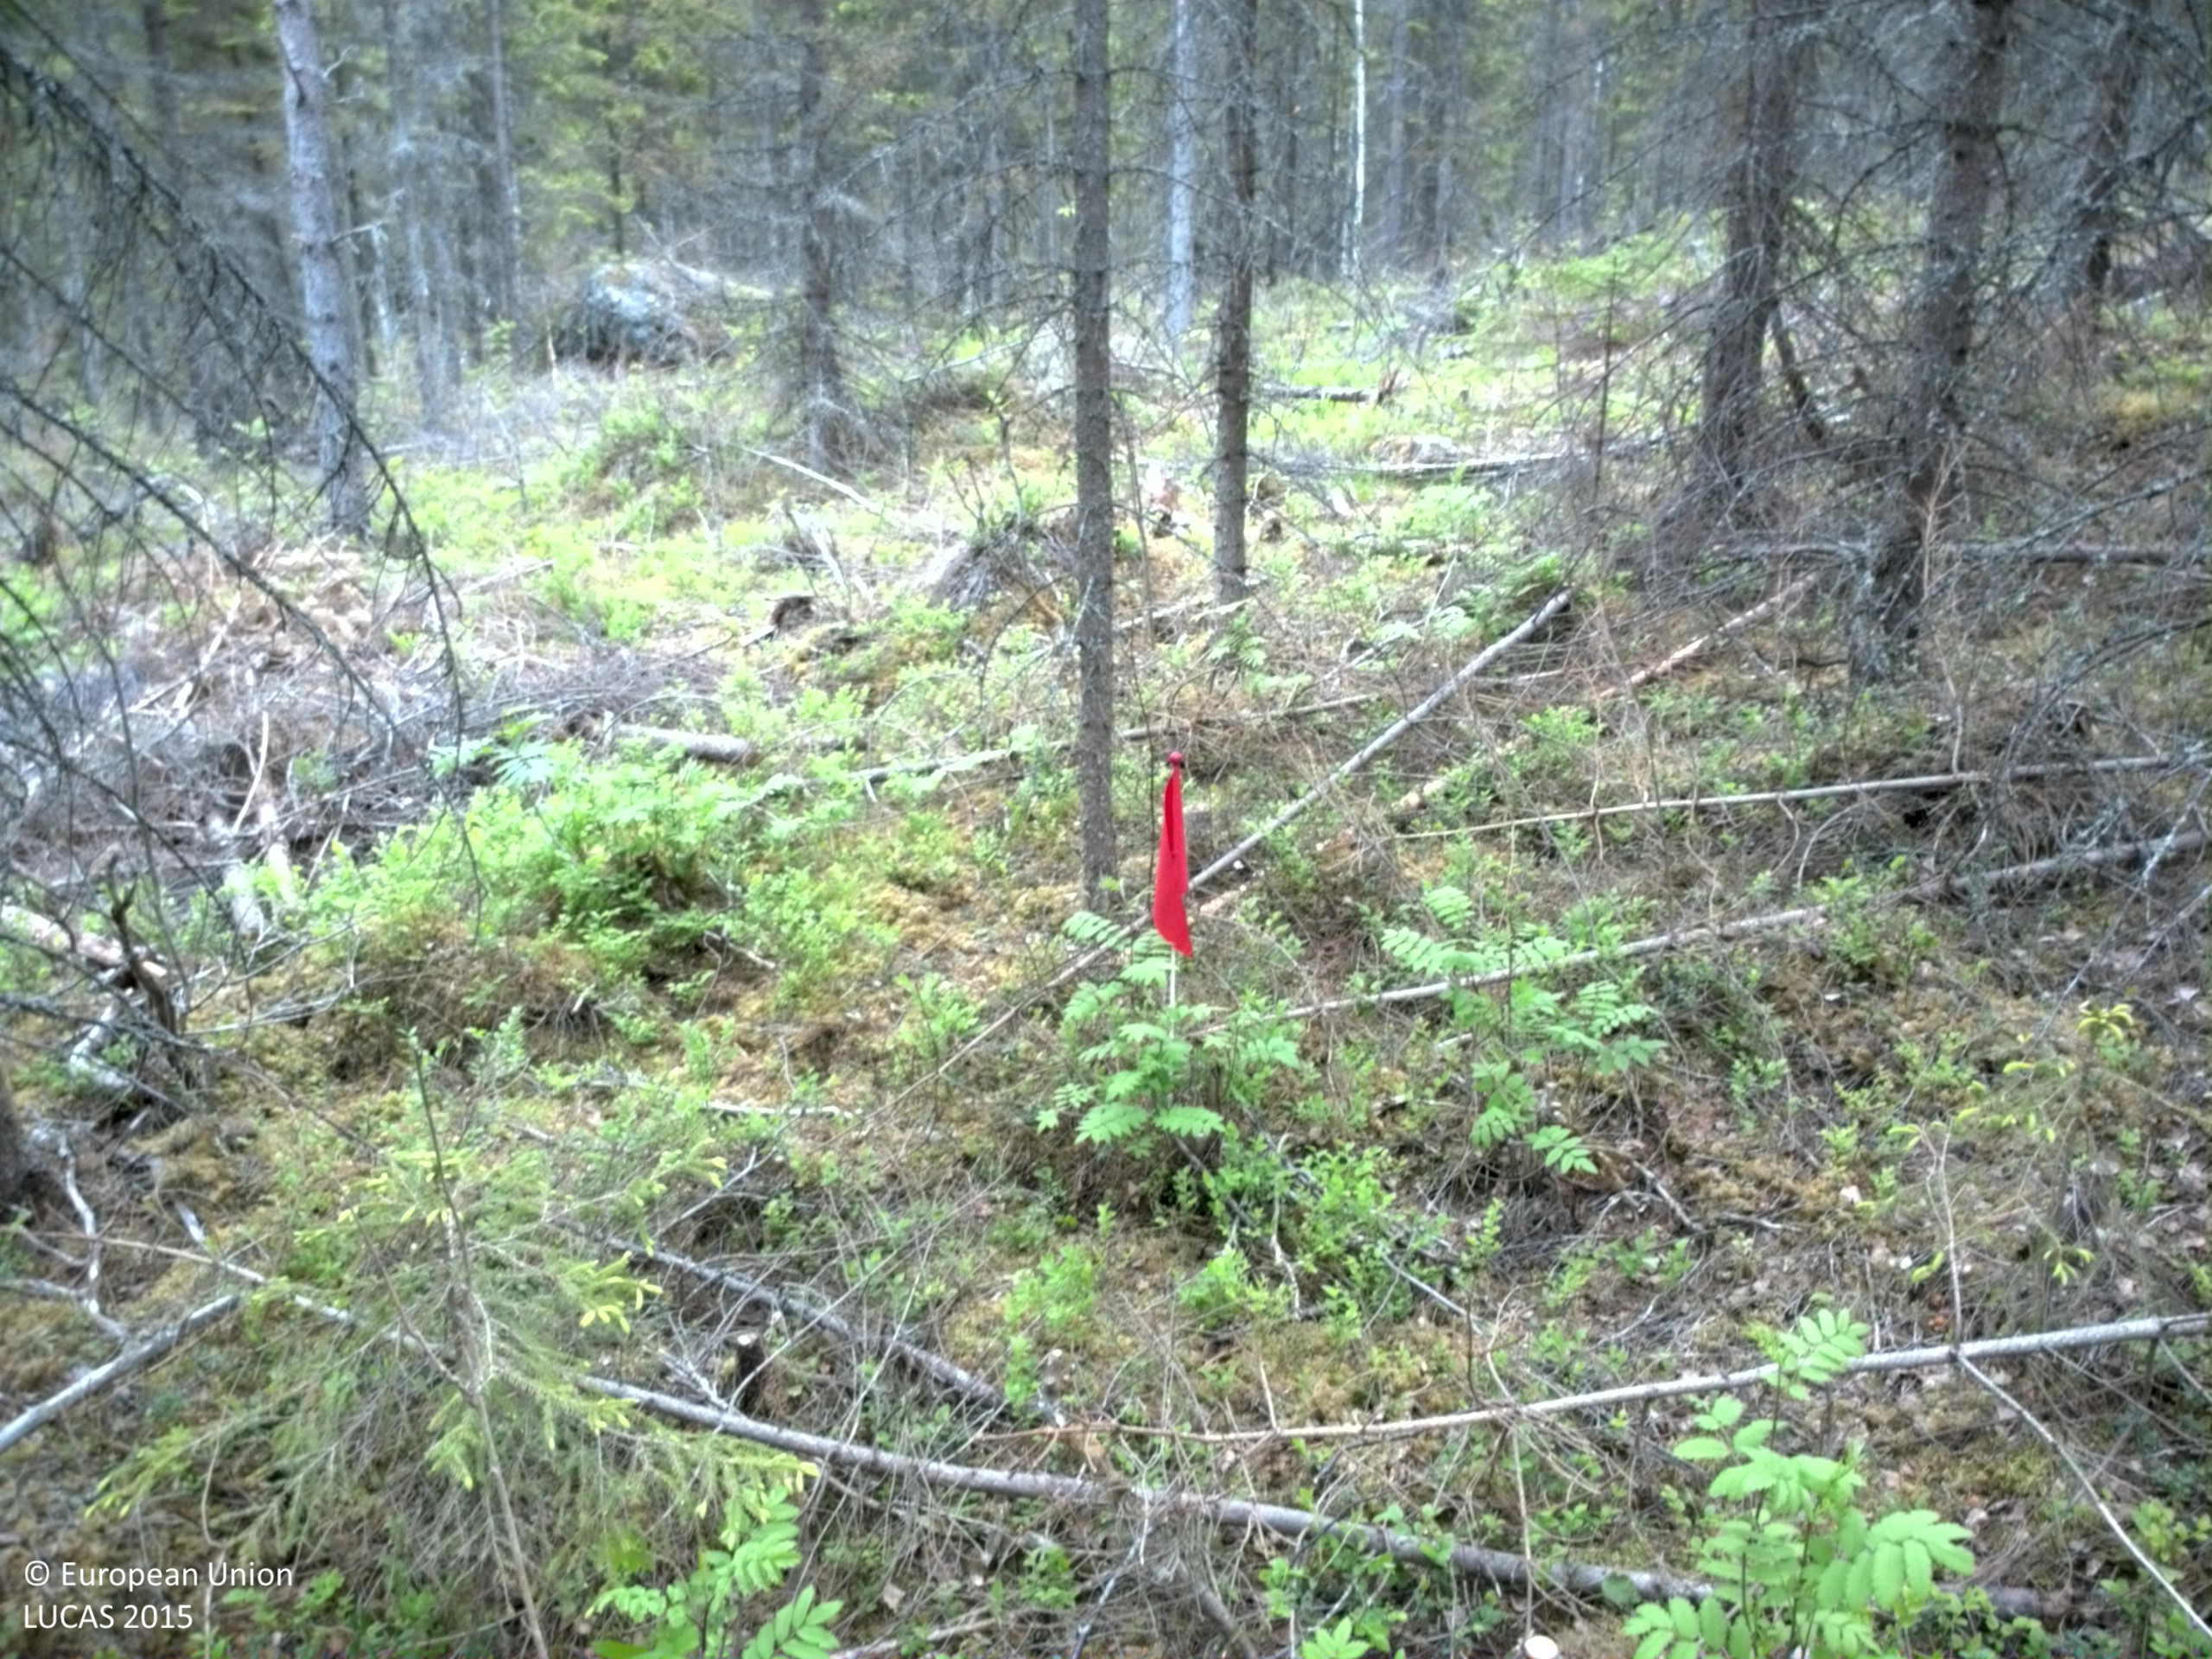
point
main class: Woodland
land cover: Spruce dominated coniferous woodland
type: boreal forest
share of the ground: > 75 %
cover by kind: coniferous forest trees 70 %, shrubs 15 %, broadleaved forest trees 5 %
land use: Forestry
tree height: > 5 m
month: June
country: SE
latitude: 63.1508
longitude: 17.8557
